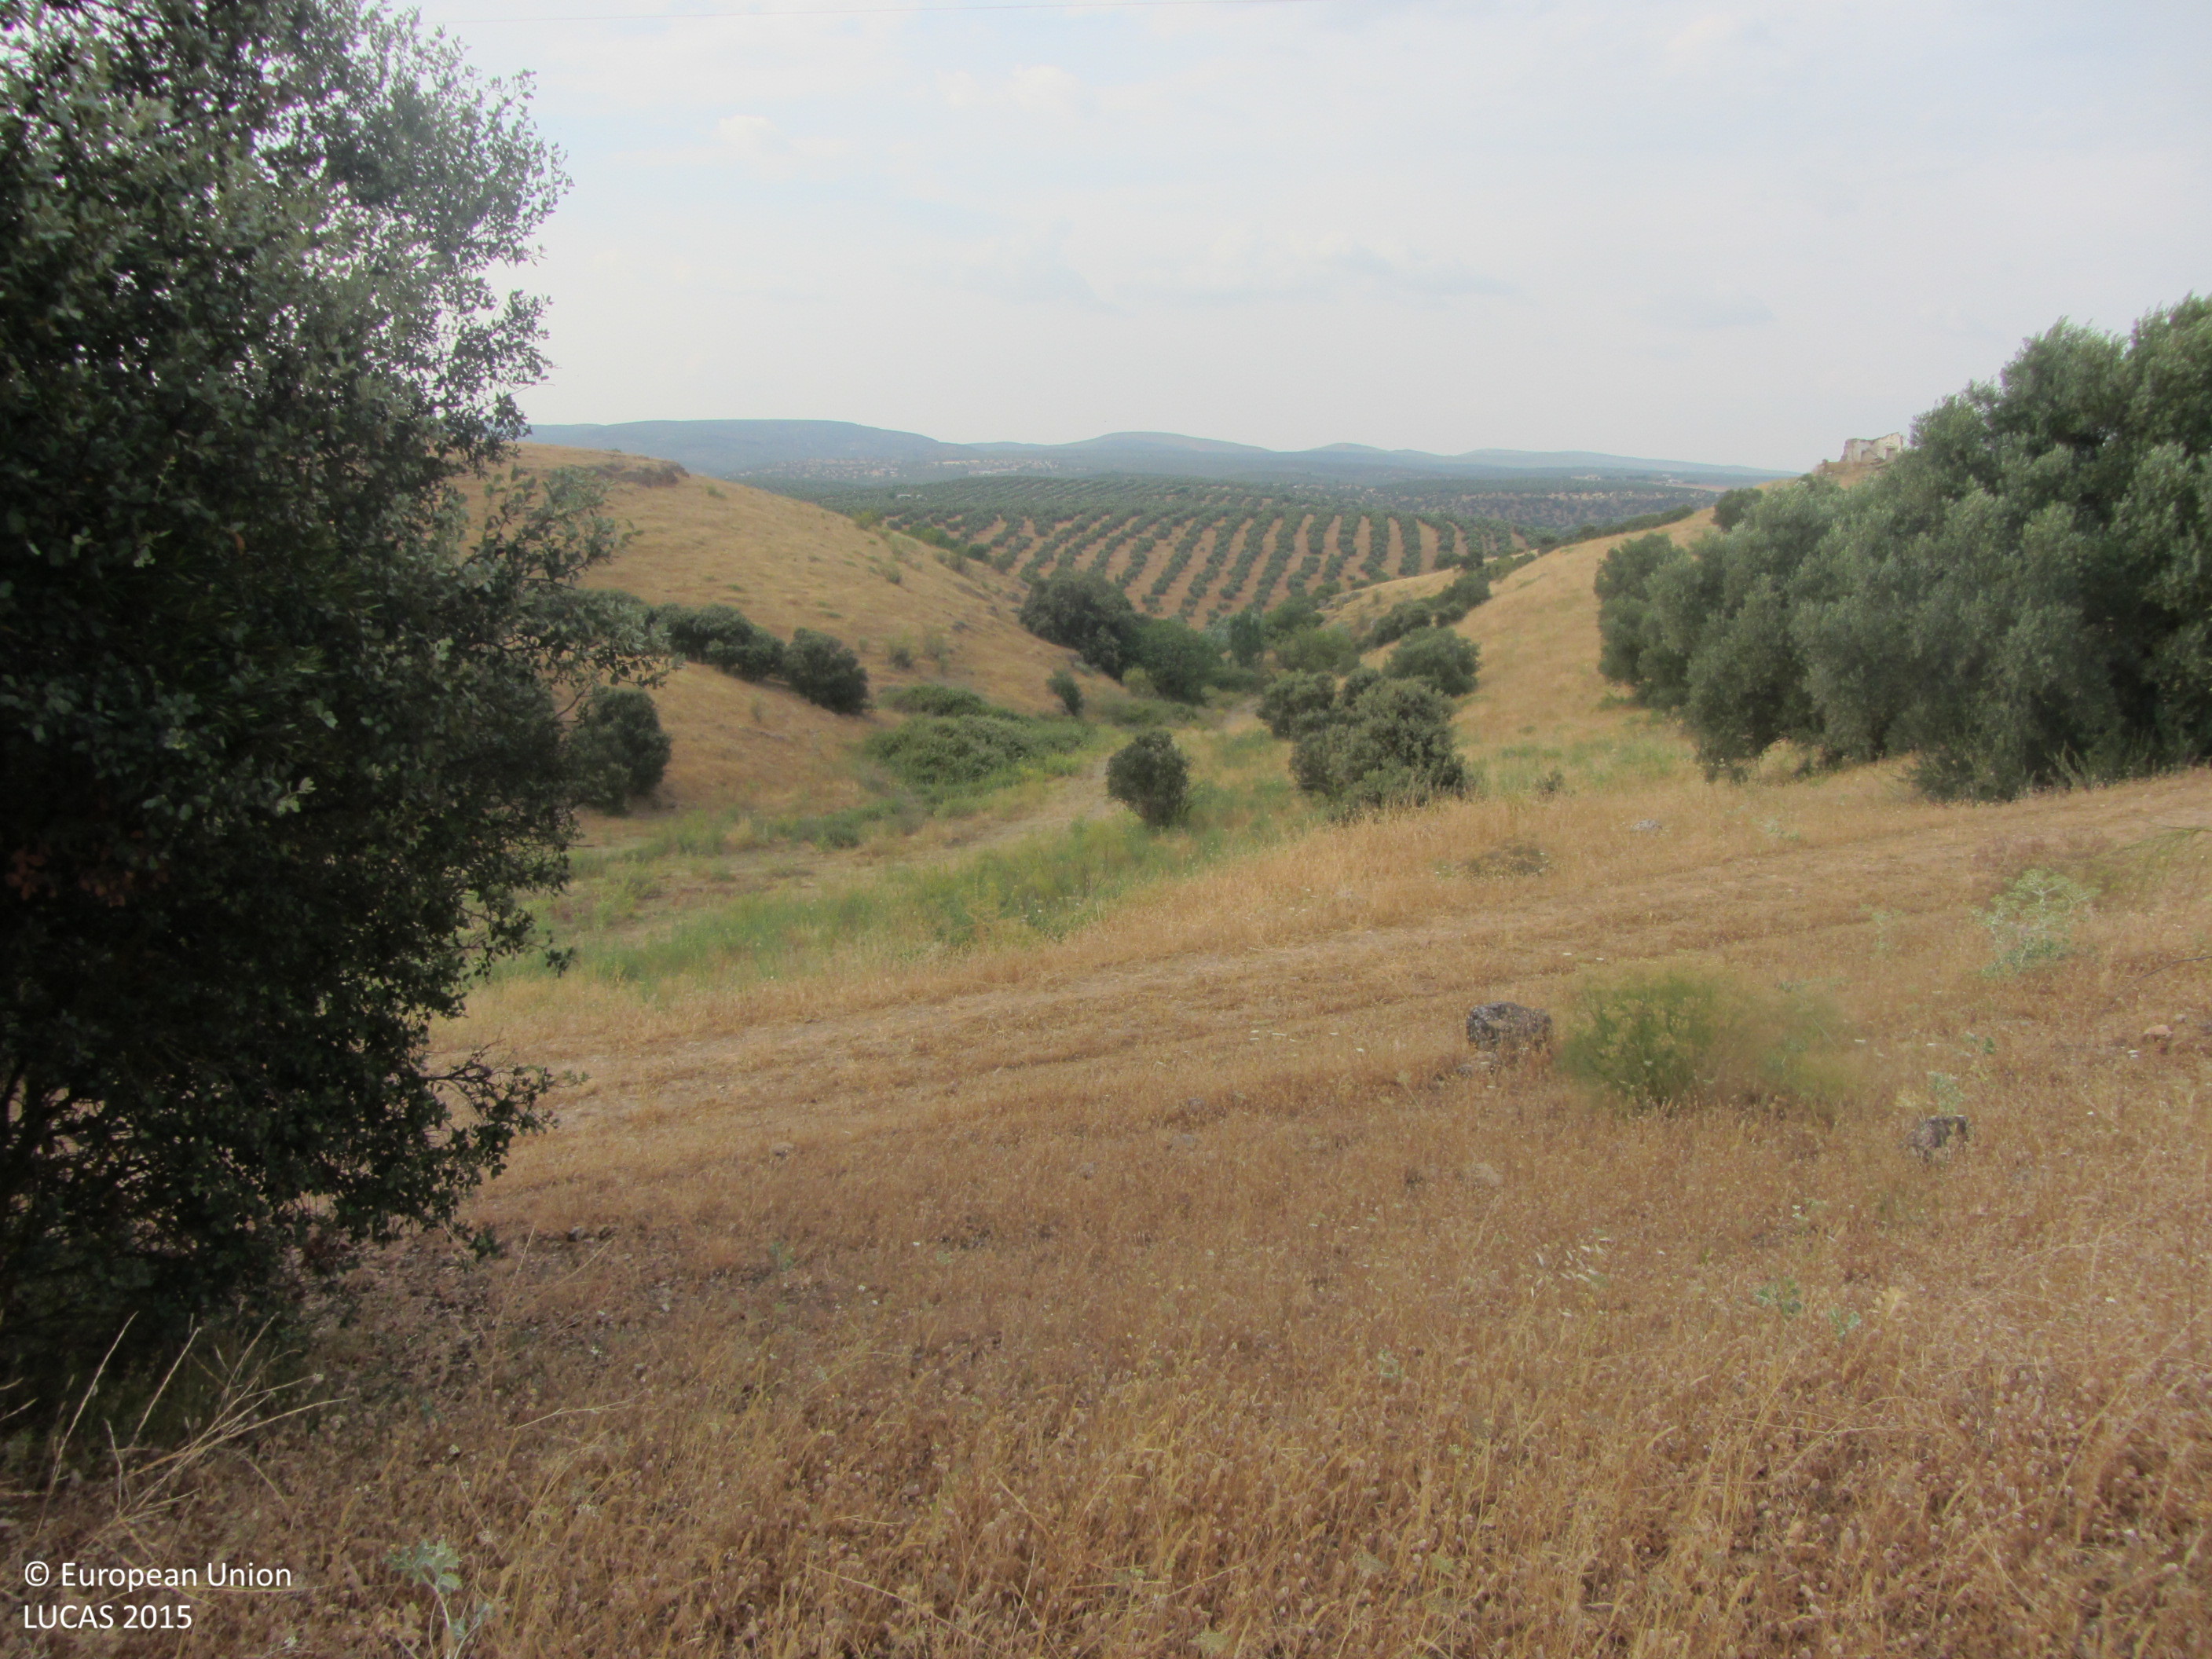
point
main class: Woodland
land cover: Broadleaved woodland
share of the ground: > 75 %
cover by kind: broadleaved forest trees 90 %, shrubs 10 %
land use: Semi-natural and natural areas not in use
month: June
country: ES
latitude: 38.1162
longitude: -3.2657
